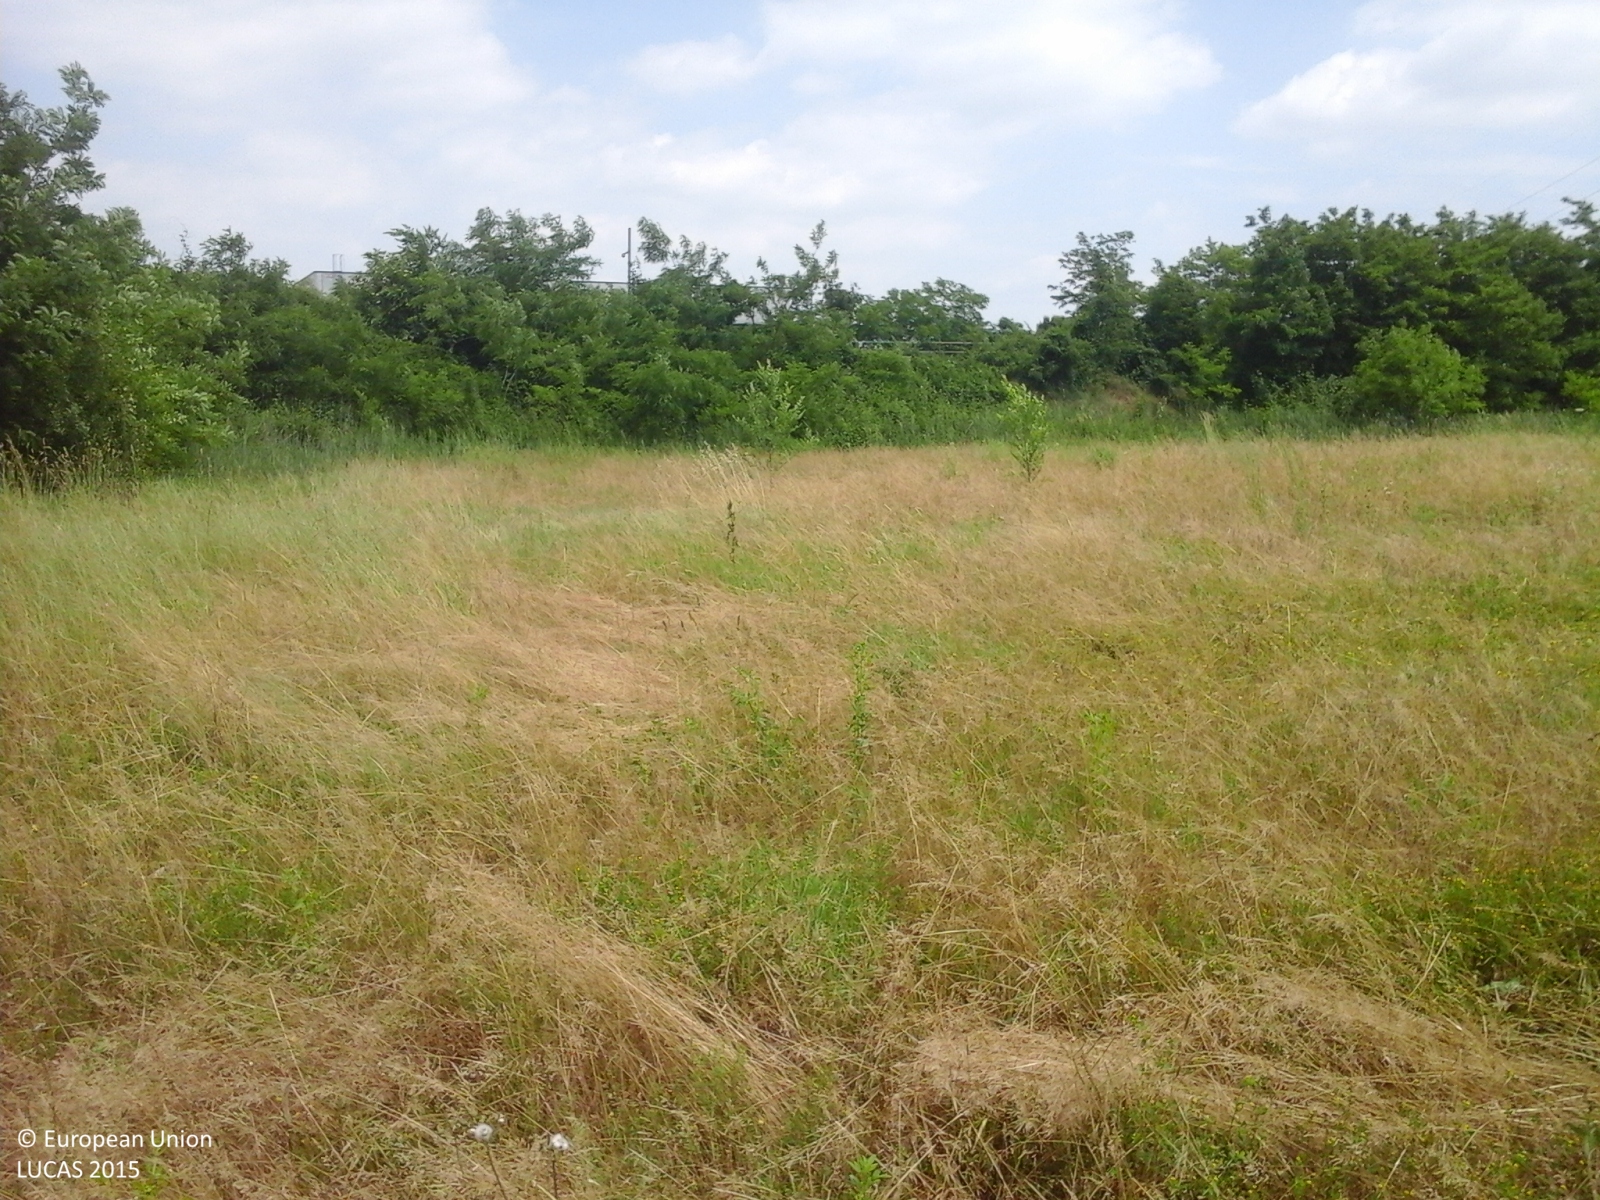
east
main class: Grassland
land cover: Grassland with sparse tree/shrub cover
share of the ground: > 75 %
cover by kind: herbaceous plants 95 %, broadleaved forest trees 5 %
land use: Abandoned areas
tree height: < 5 m
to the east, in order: Grassland with sparse tree/shrub cover; Broadleaved woodland; Railways; Abandoned hedges; Artificial constructions in urban areas; Other fruit trees and berries; Artificial constructions in urban areas; Single bushes/trees; Other fresh vegetables; Artificial constructions in urban areas
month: May
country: IT
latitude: 45.6556
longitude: 11.5247
